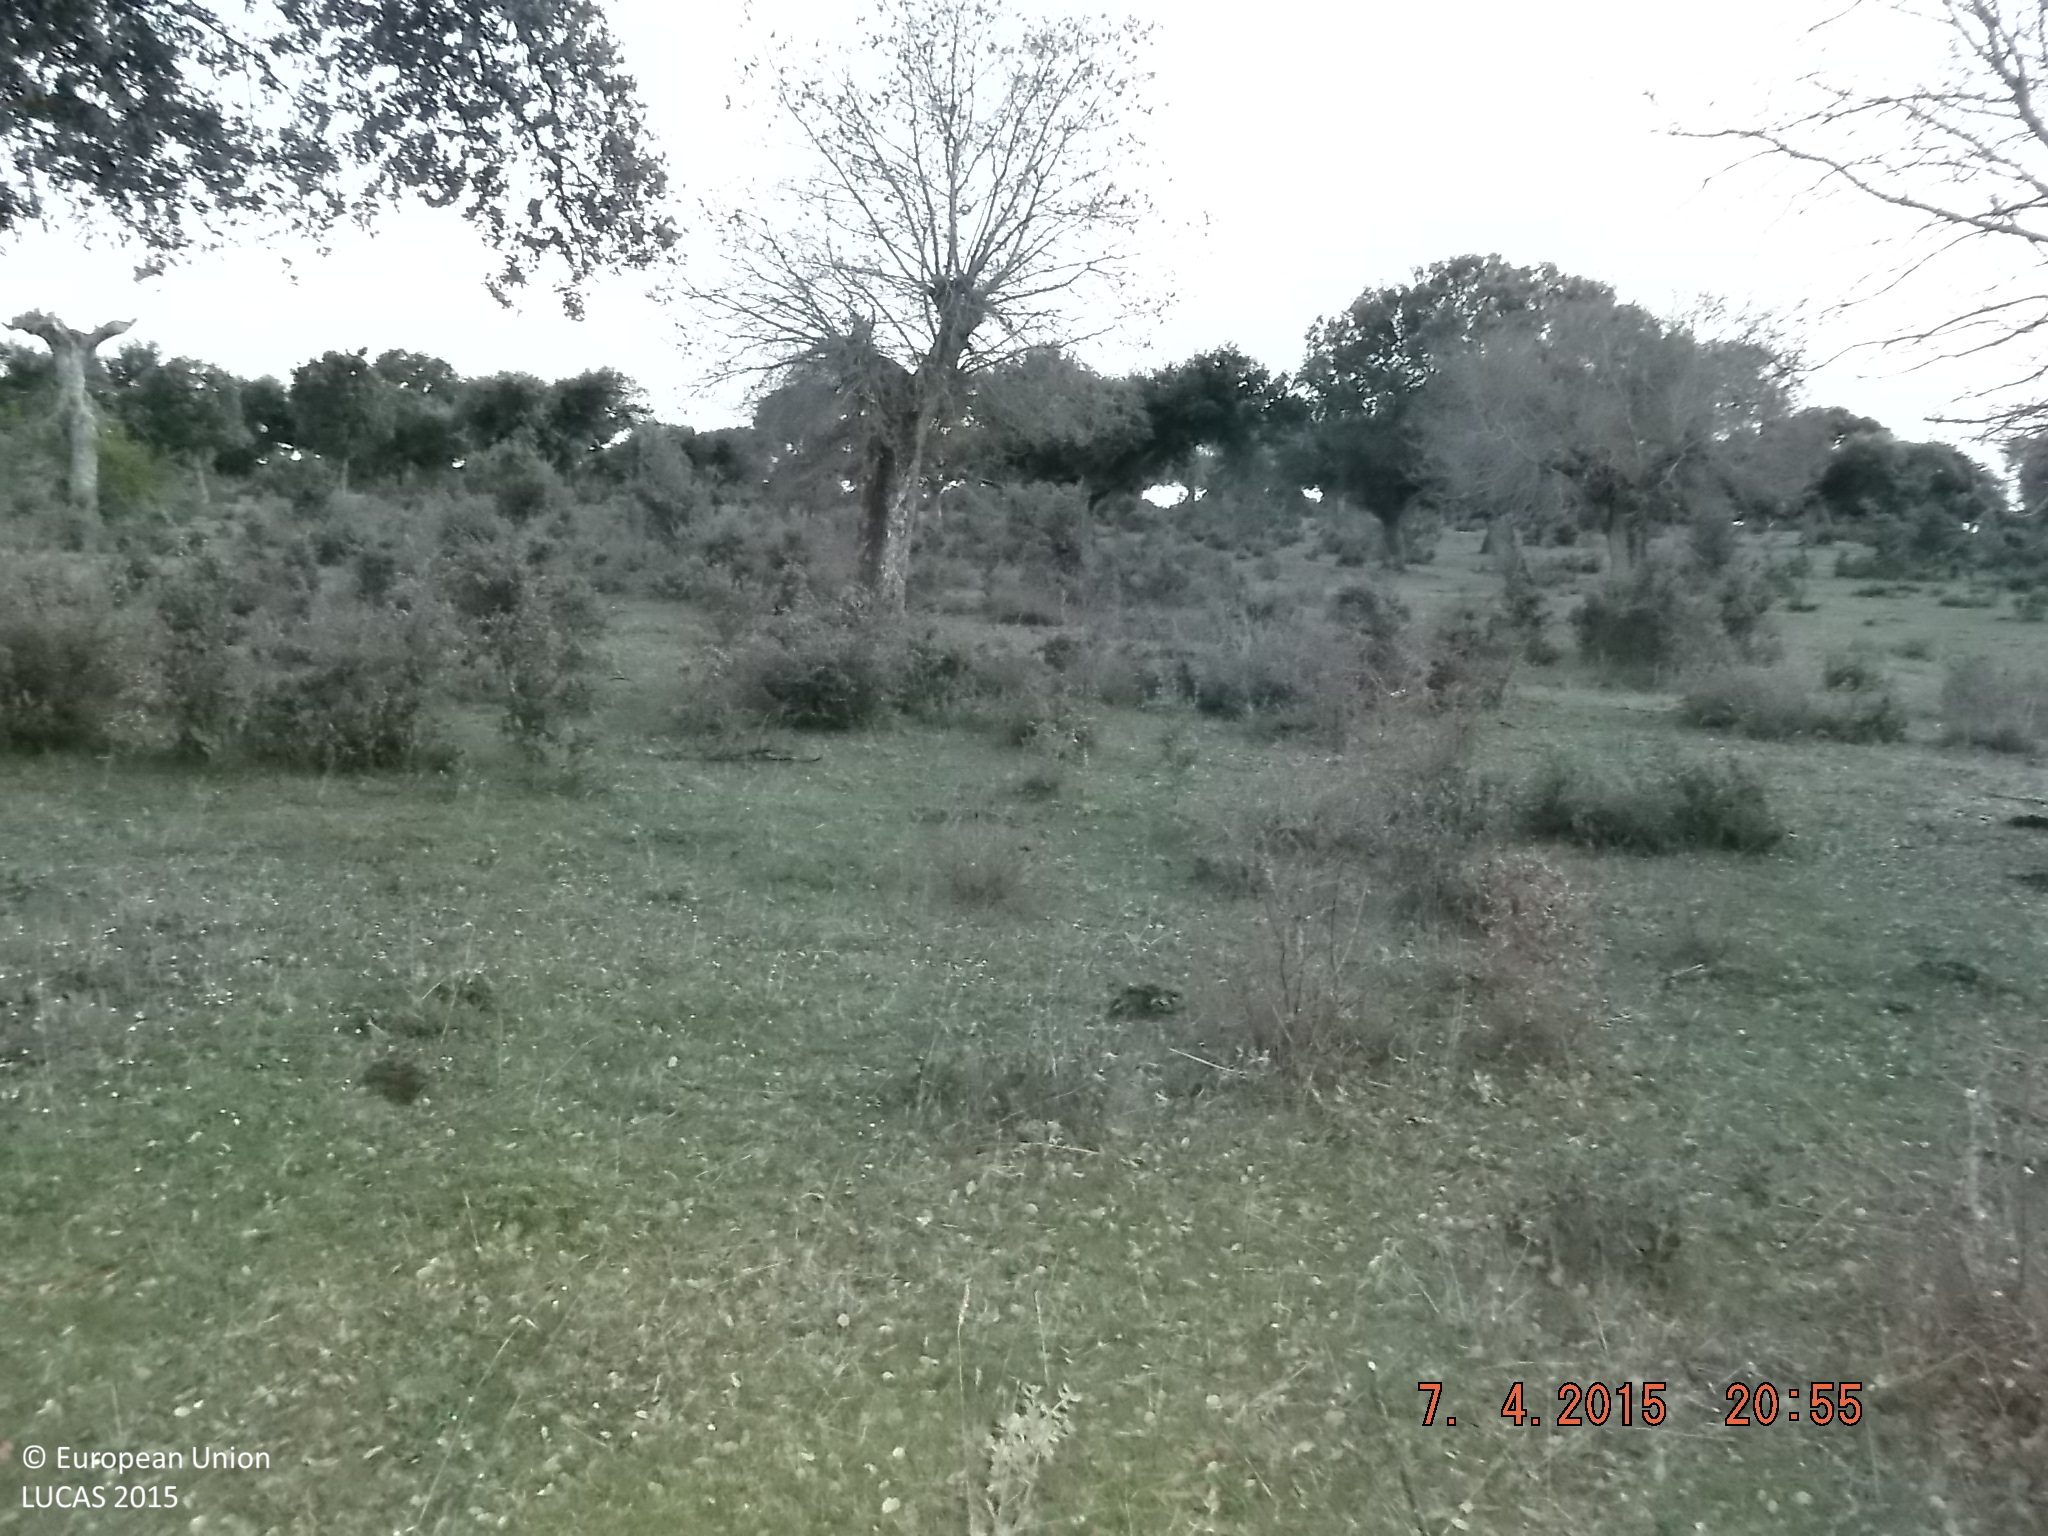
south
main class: Woodland
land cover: Broadleaved woodland
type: broadleaved evergreen forest
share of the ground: 25 - 50 %
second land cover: Shrubland without tree cover
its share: 50 - 75 %
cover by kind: shrubs 50 %, broadleaved forest trees 40 %, herbaceous plants 10 %
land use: Forestry
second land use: Agriculture (excluding fallow land and kitchen gardens)
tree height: < 5 m
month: April
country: ES
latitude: 40.8253
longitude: -5.8611
